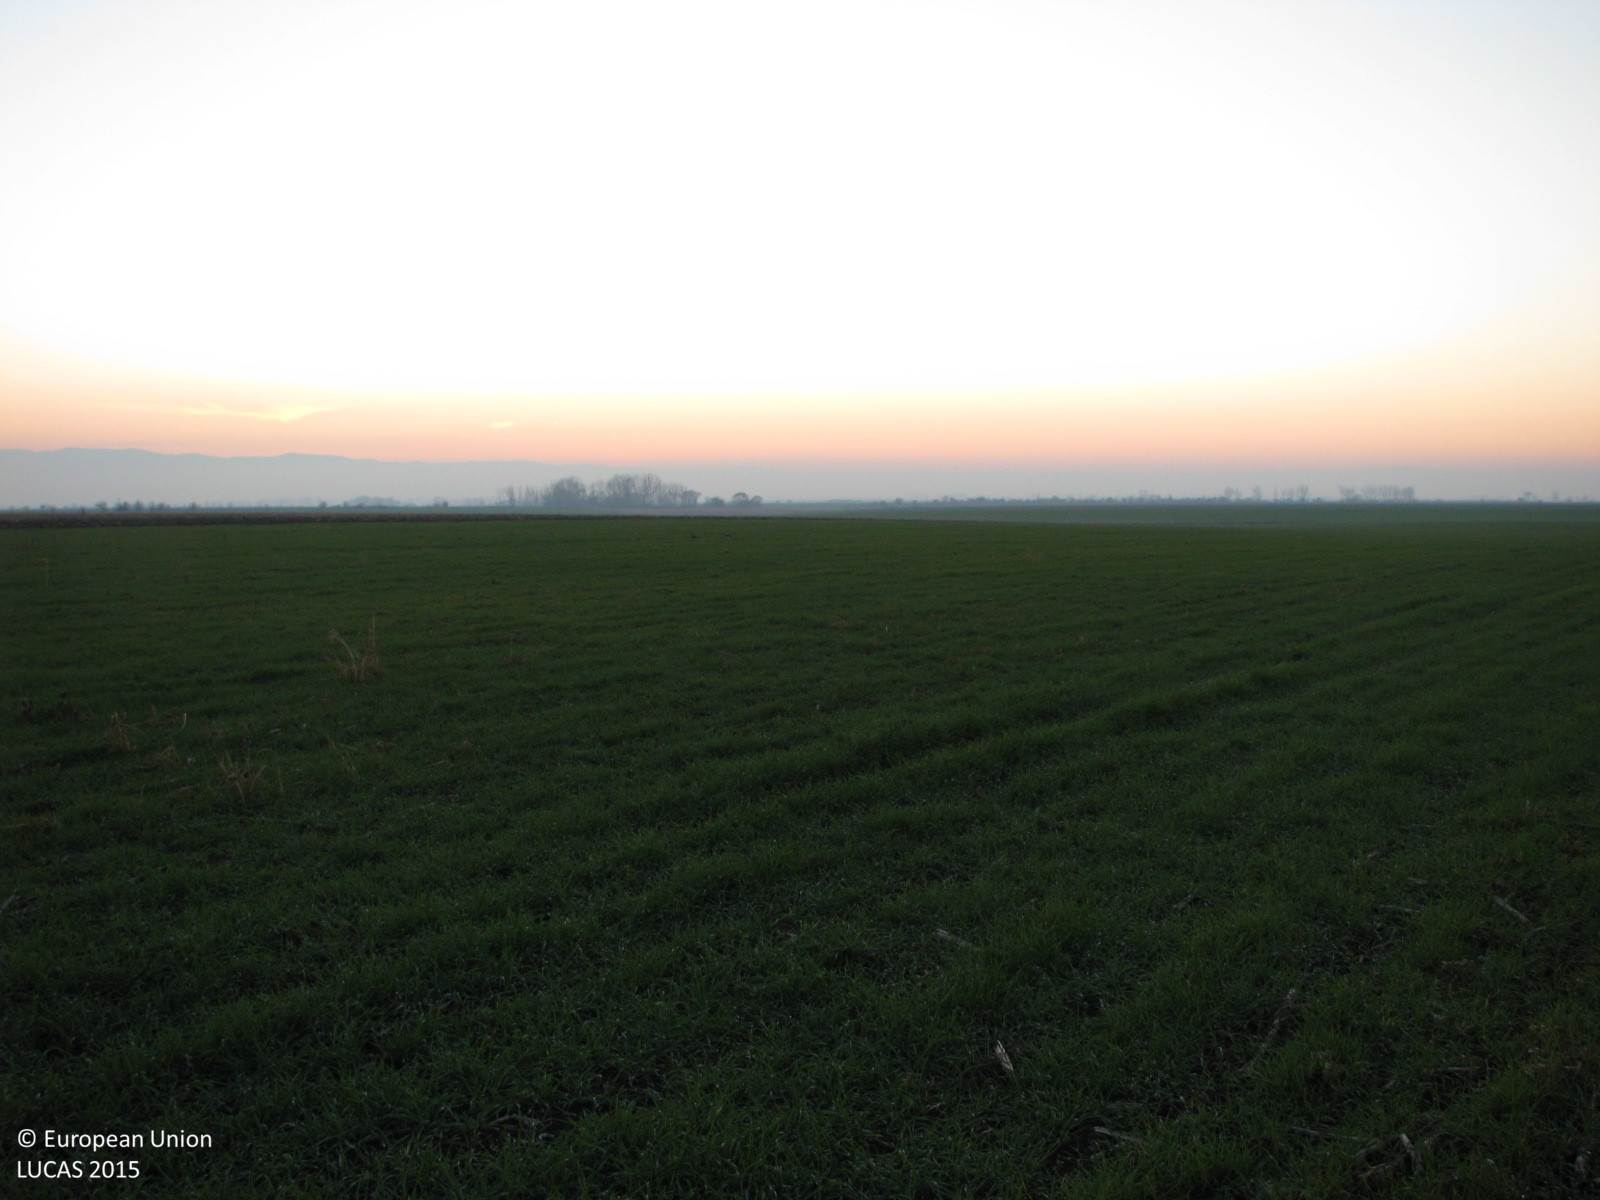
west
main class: Cropland
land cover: Common wheat
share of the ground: > 75 %
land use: Agriculture (excluding fallow land and kitchen gardens)
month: December
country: BG
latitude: 42.2978
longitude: 25.0138
